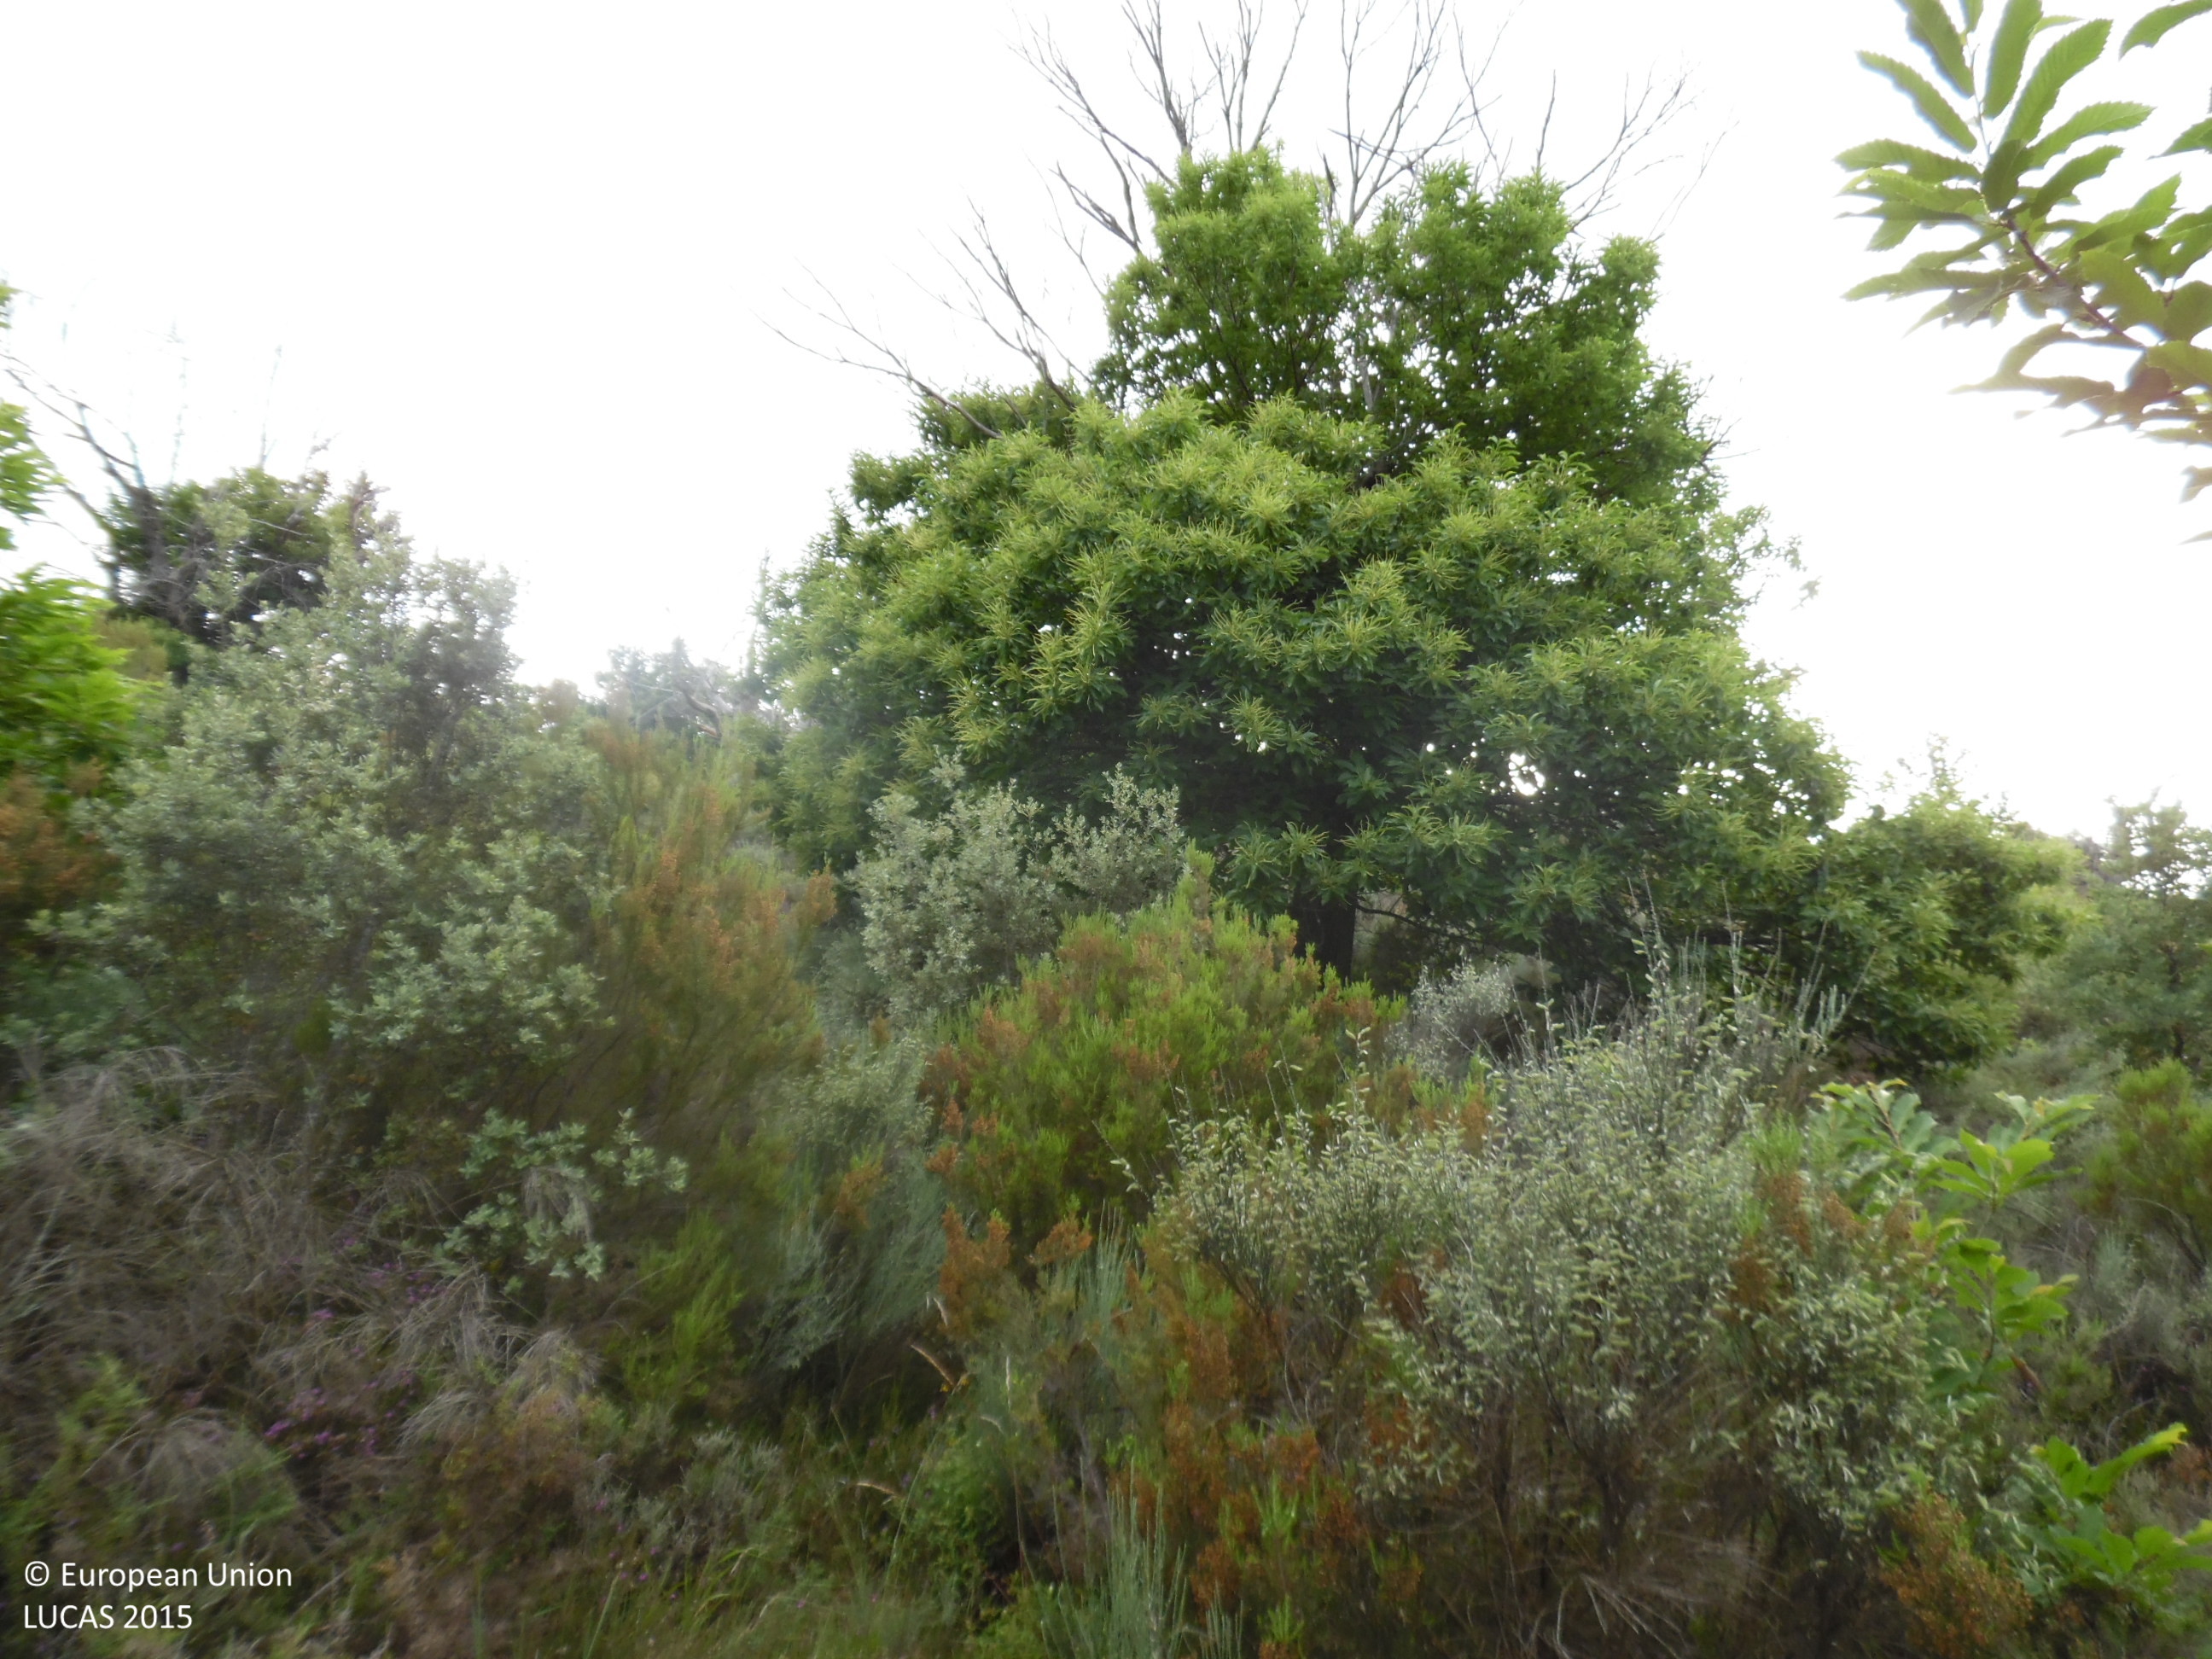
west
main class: Woodland
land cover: Broadleaved woodland
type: thermophilous deciduous forest
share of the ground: > 75 %
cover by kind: broadleaved forest trees 90 %, shrubs 5 %, consolidated bare surface 5 %
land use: Semi-natural and natural areas not in use
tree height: > 5 m
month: June
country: ES
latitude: 42.5708
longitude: -6.4280
